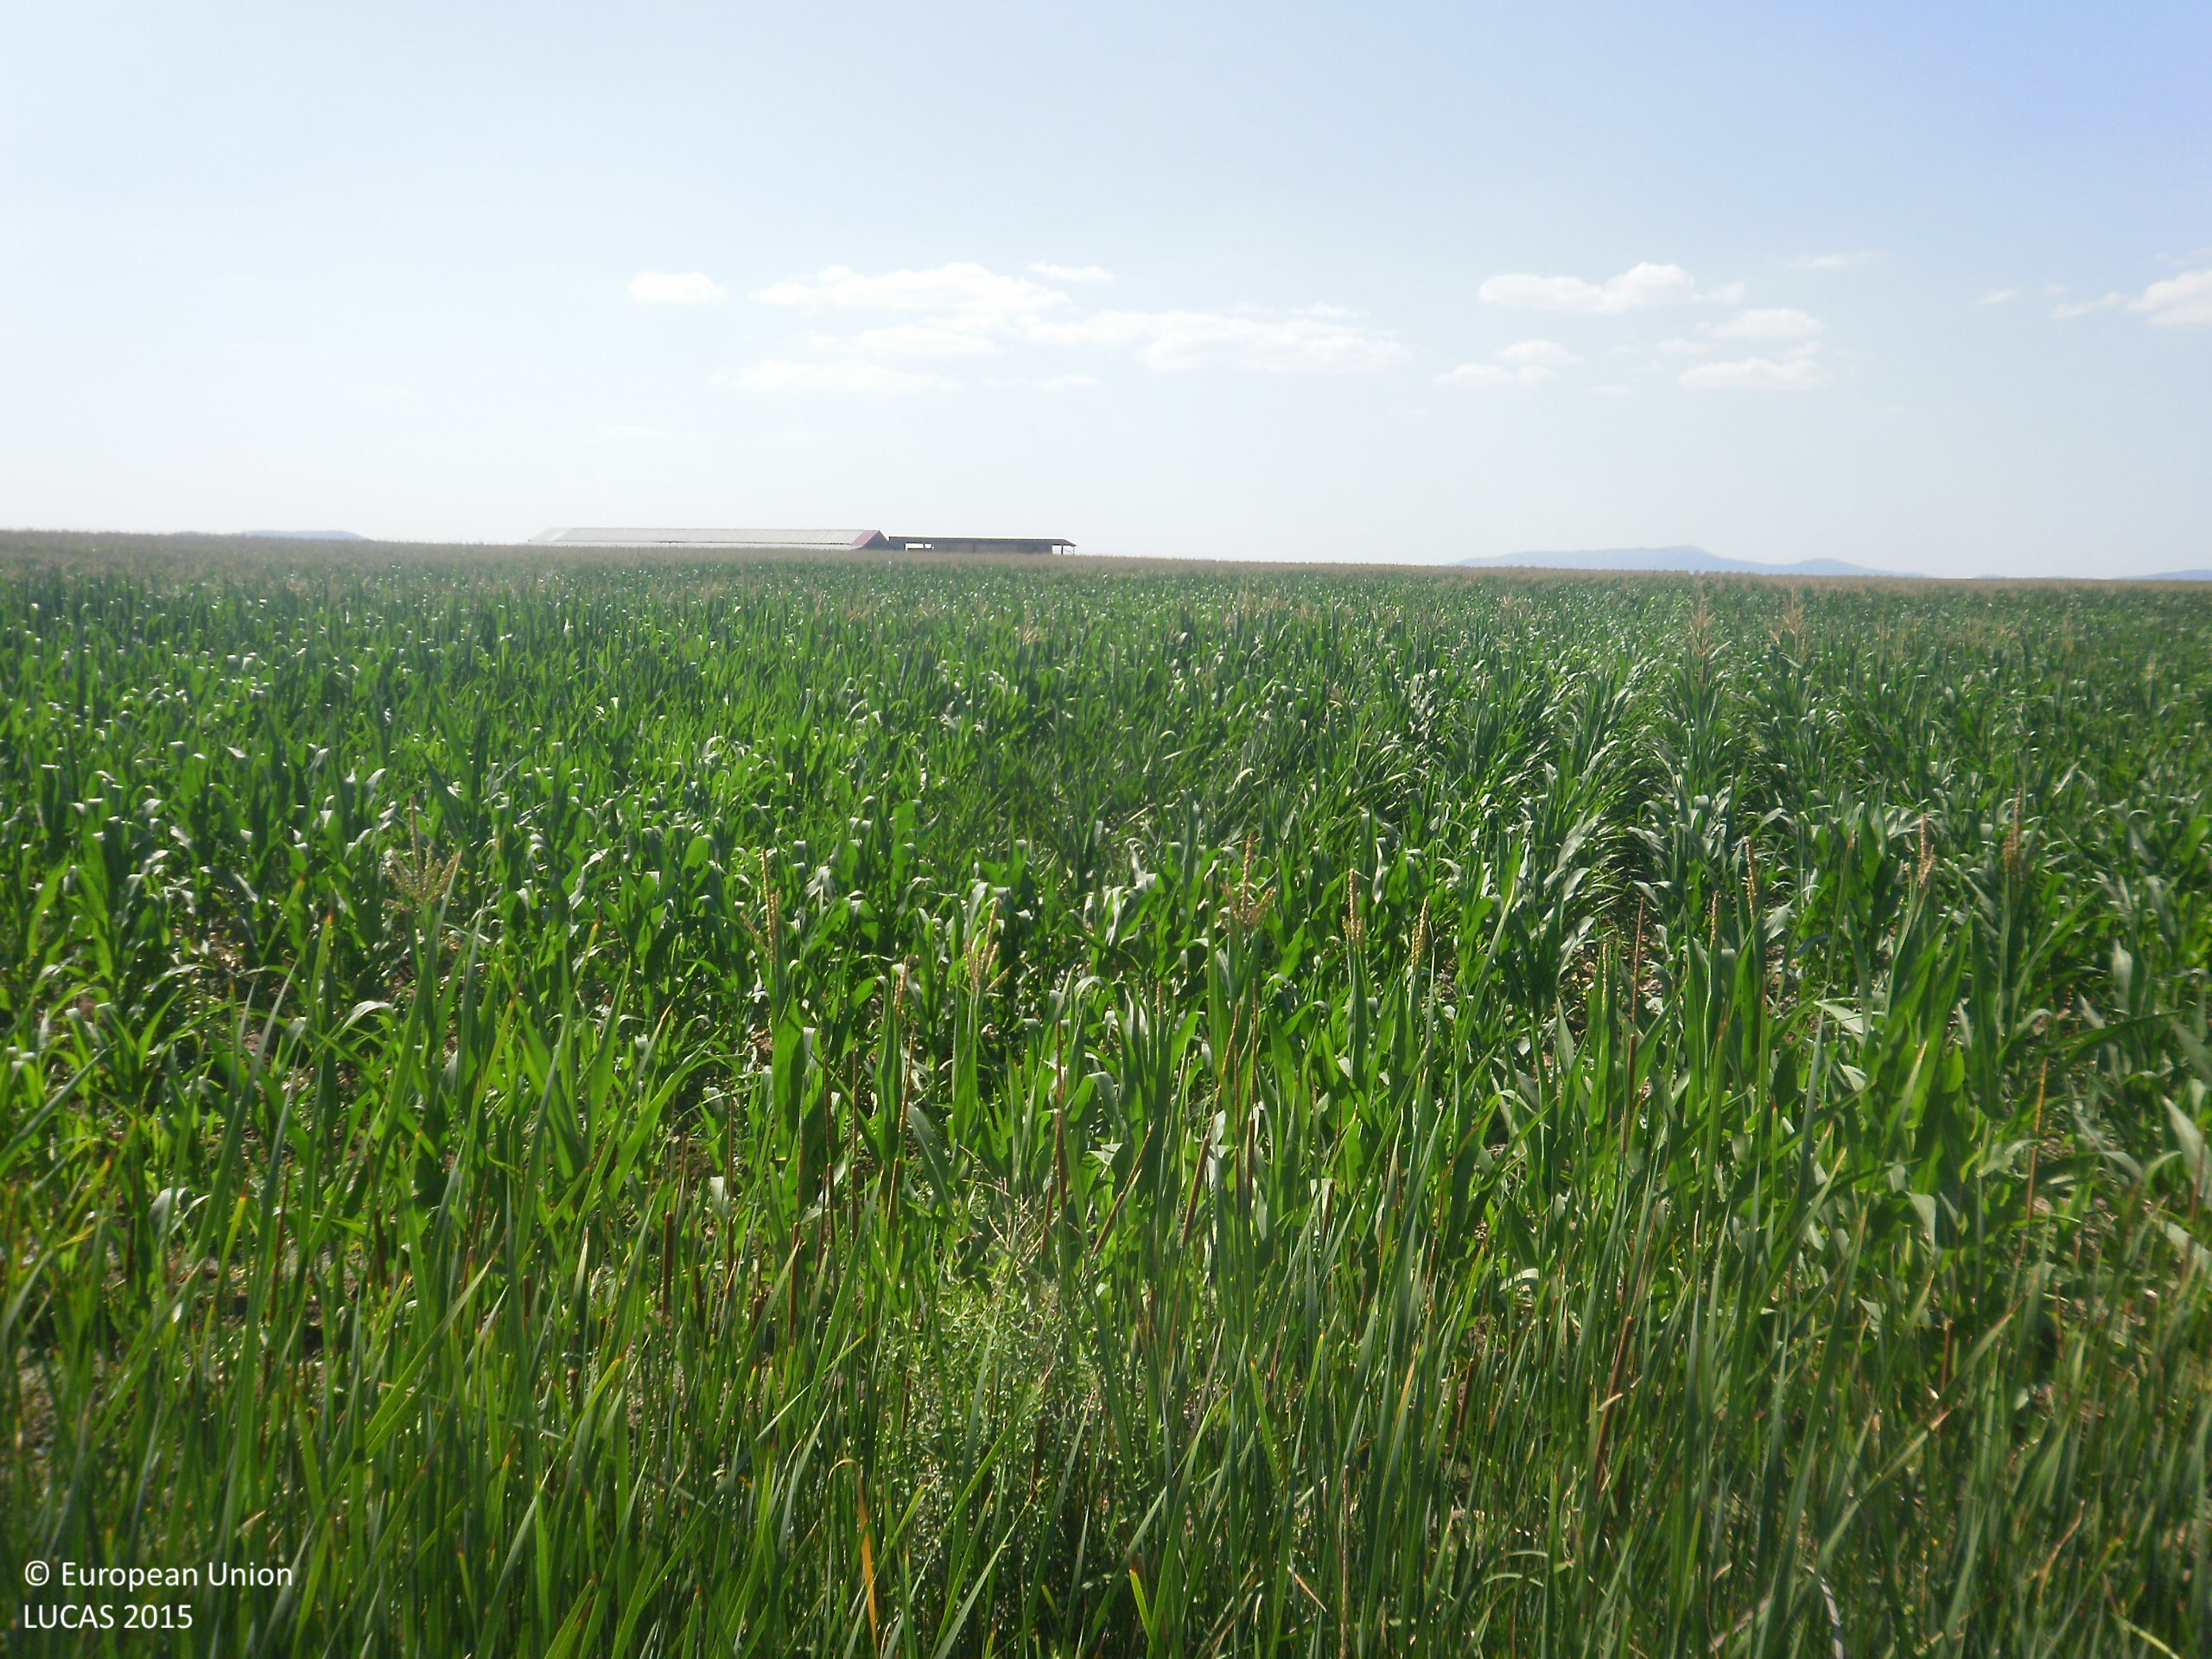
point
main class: Cropland
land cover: Maize
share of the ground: > 75 %
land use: Agriculture (excluding fallow land and kitchen gardens)
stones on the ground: < 10 %
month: June
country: ES
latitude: 39.0569
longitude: -5.9890
